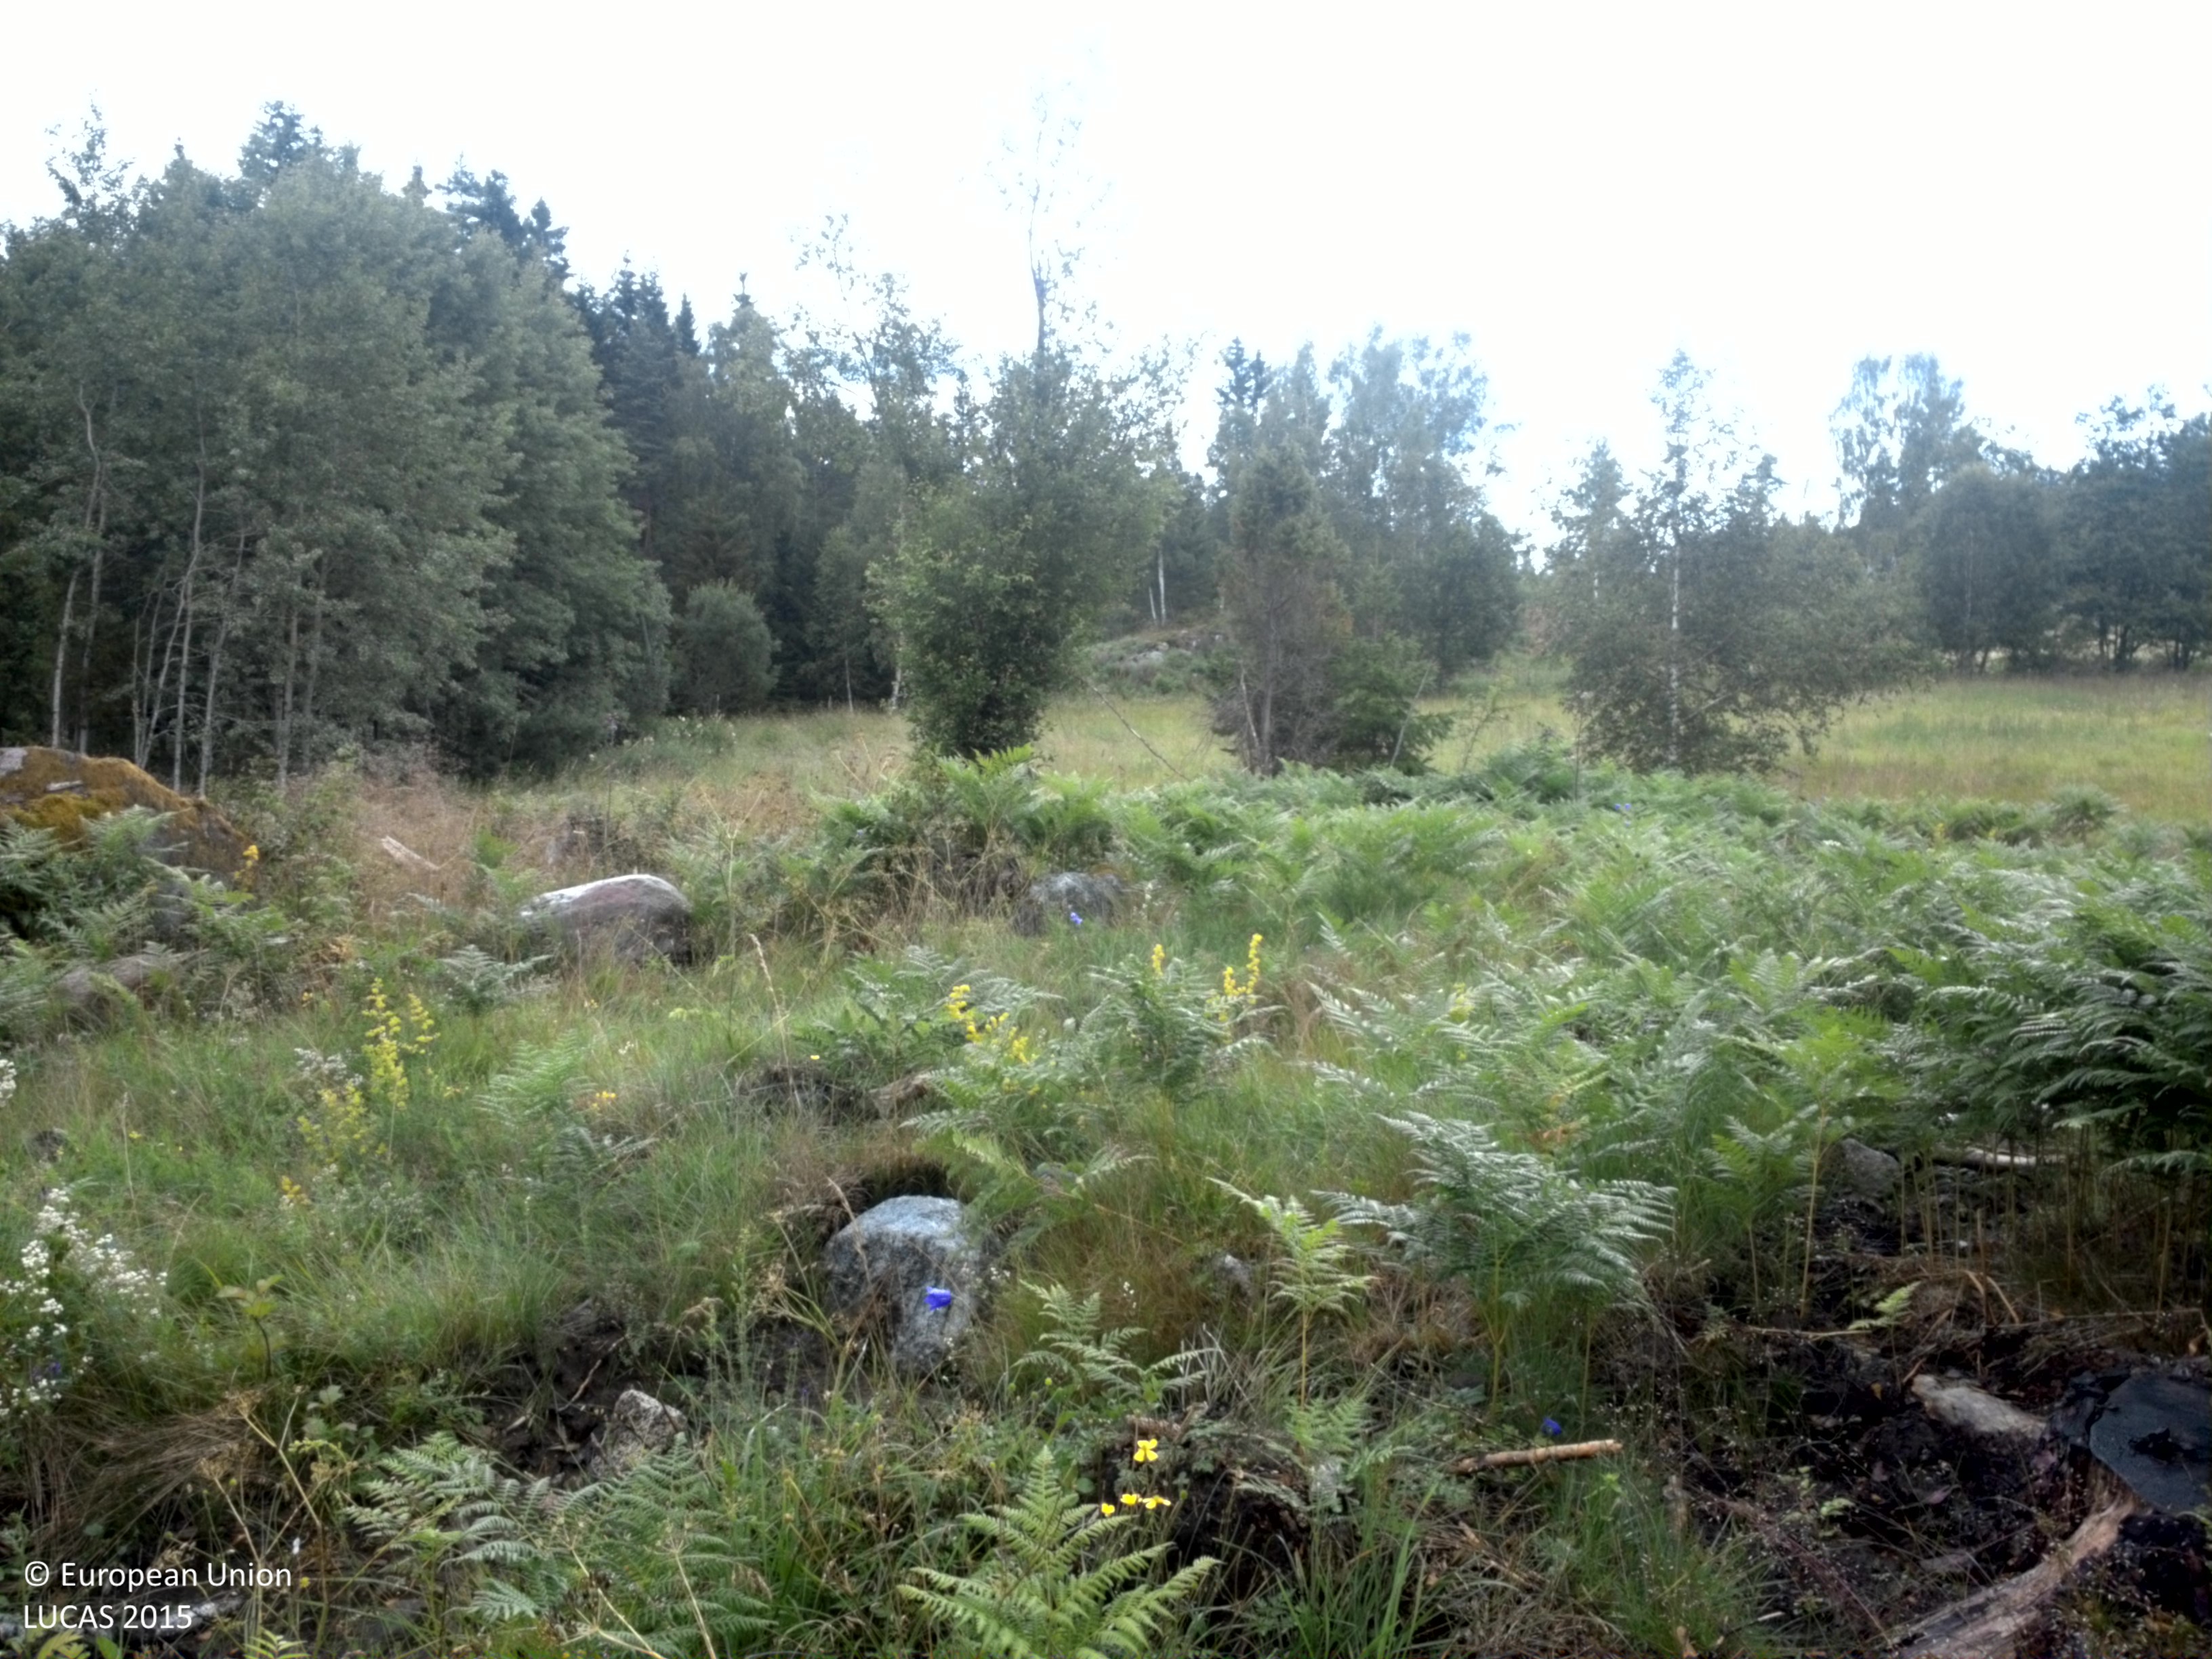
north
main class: Woodland
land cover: Broadleaved woodland
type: hemiboreal forest and nemoral coniferous forest and mixed broadleaved-coniferous forest
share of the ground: 10 - 25 %
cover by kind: herbaceous plants 85 %, broadleaved forest trees 15 %
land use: Forestry
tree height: < 5 m
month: July
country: SE
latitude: 59.9042
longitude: 18.5263
